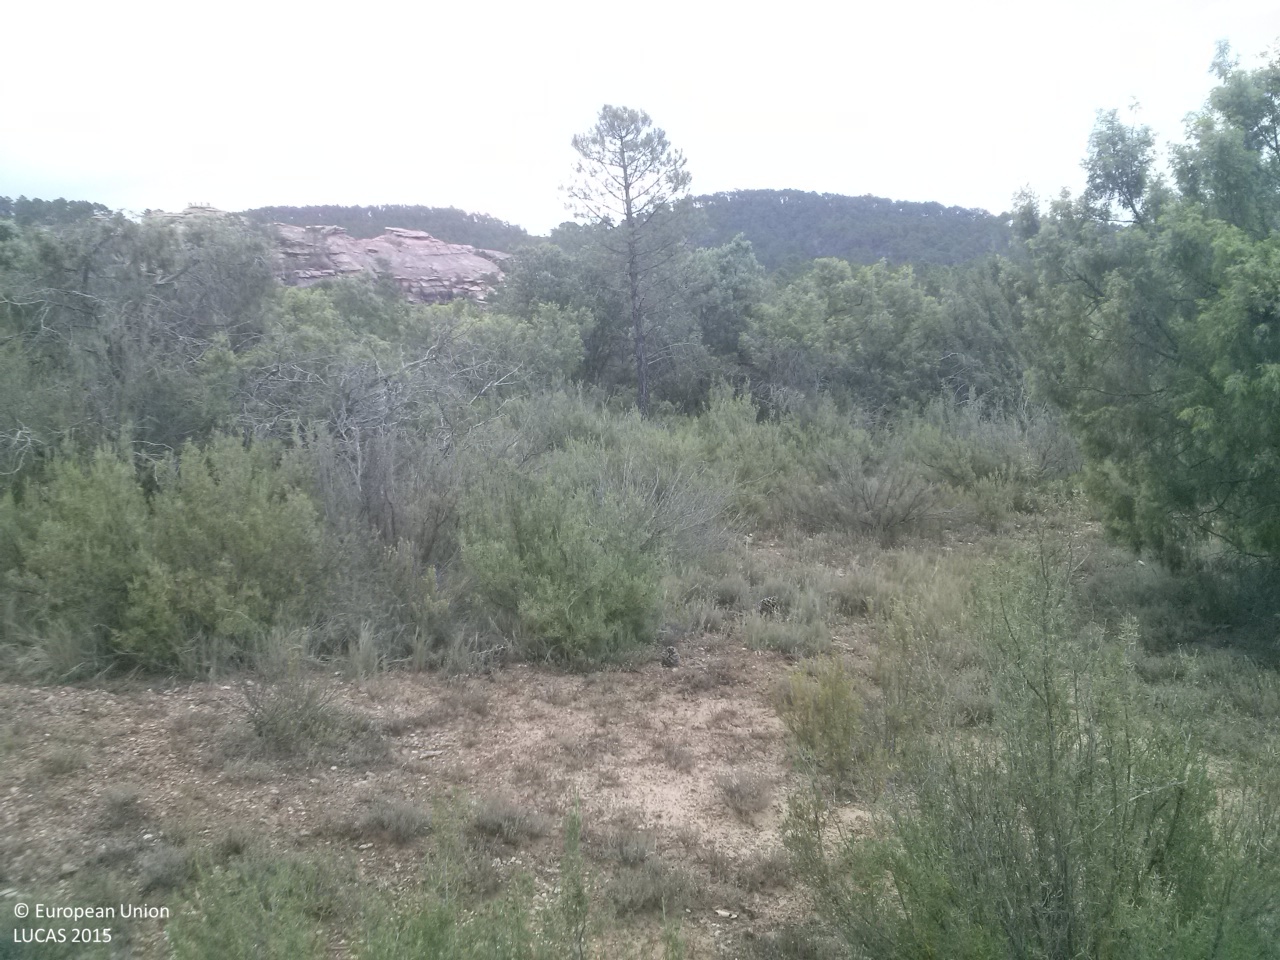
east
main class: Woodland
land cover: Pine dominated coniferous woodland
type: coniferous forest of the mediterranean region
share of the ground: 25 - 50 %
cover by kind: coniferous forest trees 30 %, shrubs 30 %, herbaceous plants 20 %, unconsolidated bare surface 20 %
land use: Forestry
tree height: > 5 m
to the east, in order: Pine dominated coniferous woodland; Tracks; Pine dominated coniferous woodland; Shrubland with sparse tree cover
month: June
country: ES
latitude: 39.9149
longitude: -1.6738
